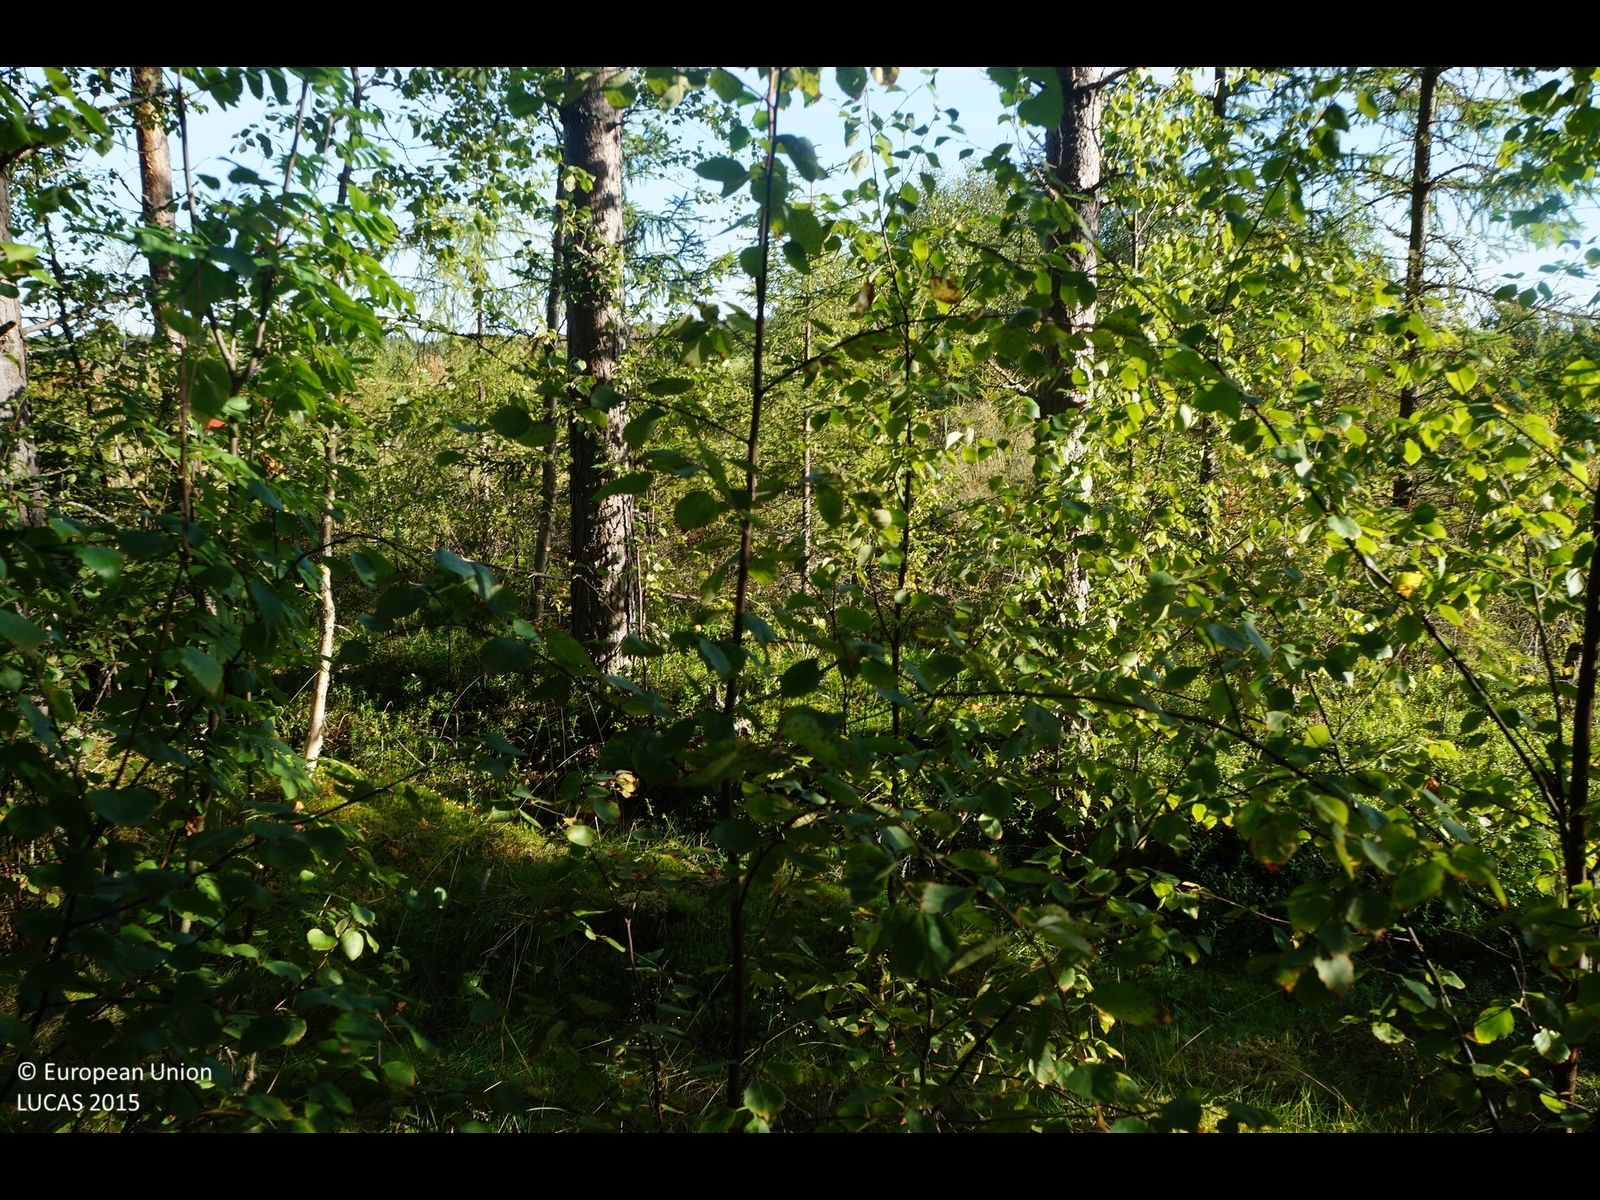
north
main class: Woodland
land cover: Pine dominated coniferous woodland
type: boreal forest
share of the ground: 50 - 75 %
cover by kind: coniferous forest trees 50 %, shrubs 35 %, lichens and mosses 10 %, herbaceous plants 5 %
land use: Forestry
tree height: > 5 m
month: August
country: FI
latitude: 64.8757
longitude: 25.0415
